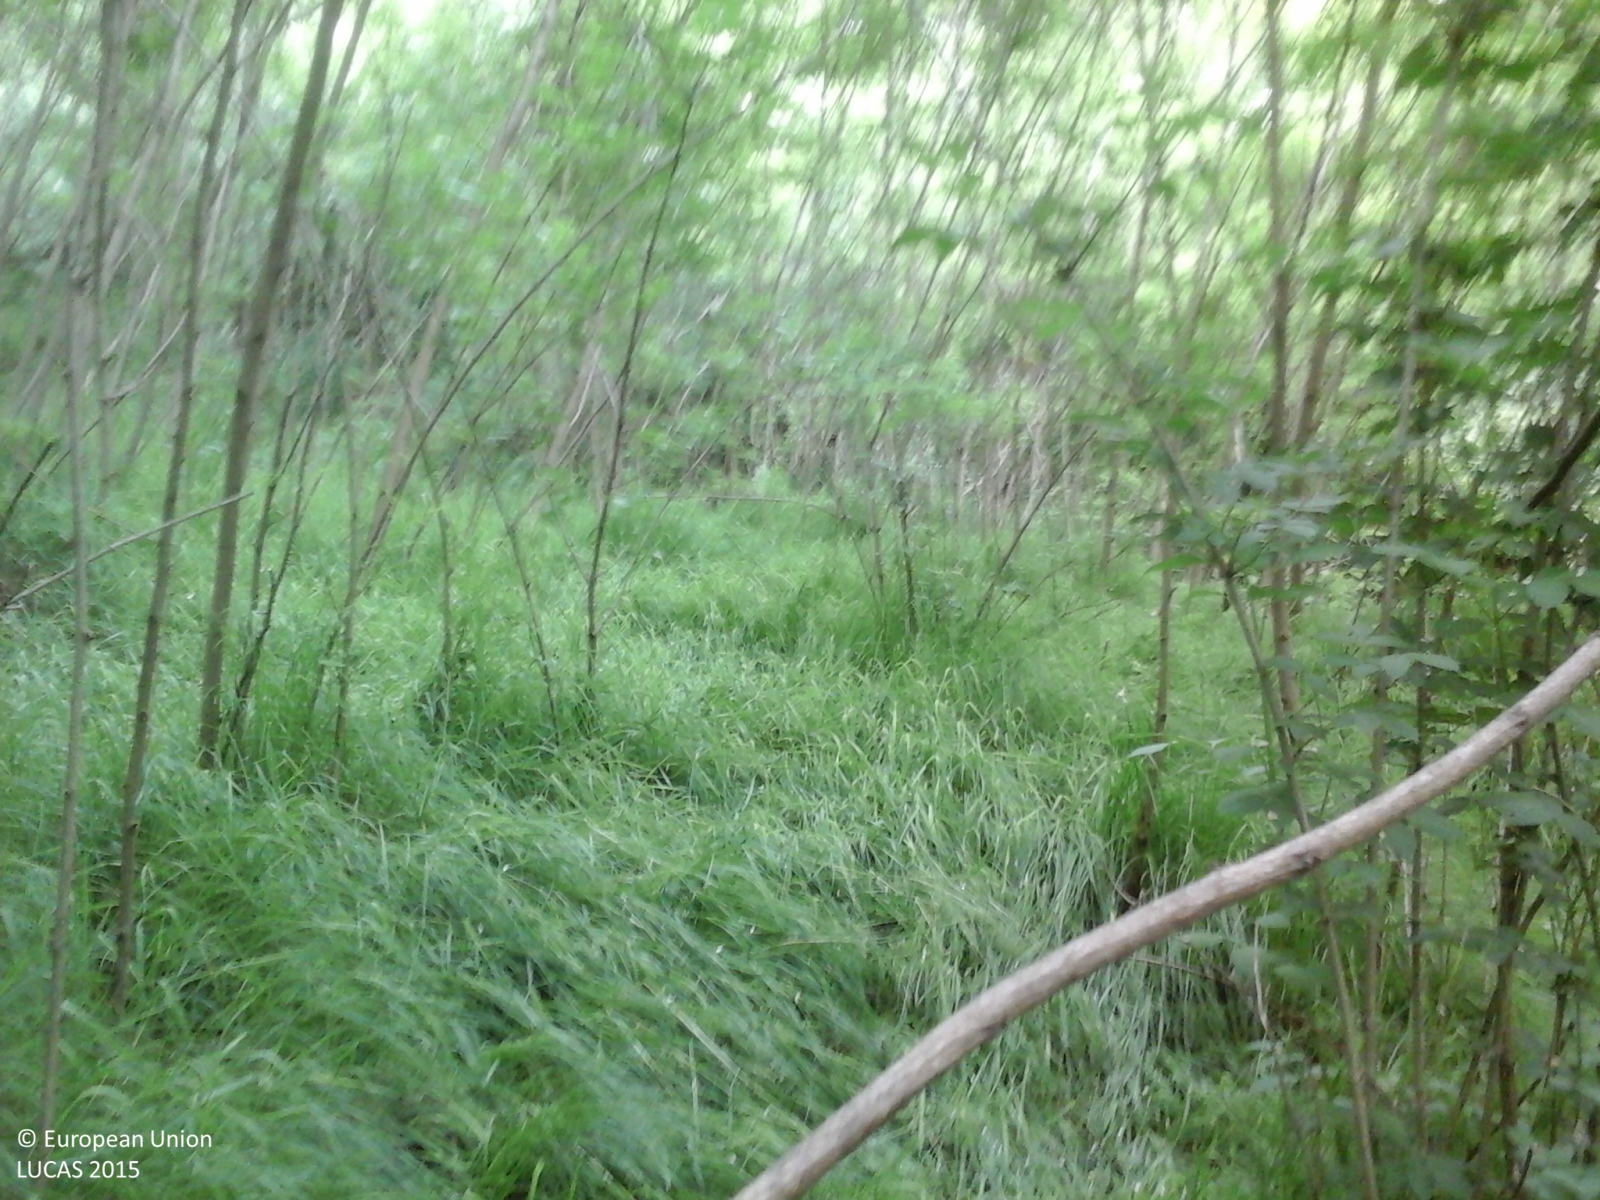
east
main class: Woodland
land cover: Broadleaved woodland
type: thermophilous deciduous forest
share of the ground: > 75 %
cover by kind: broadleaved forest trees 100 %
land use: Forestry
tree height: > 5 m
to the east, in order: Broadleaved woodland; Tracks; Broadleaved woodland; Ditches and canals; Broadleaved woodland
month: May
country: IT
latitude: 45.7475
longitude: 8.6011
